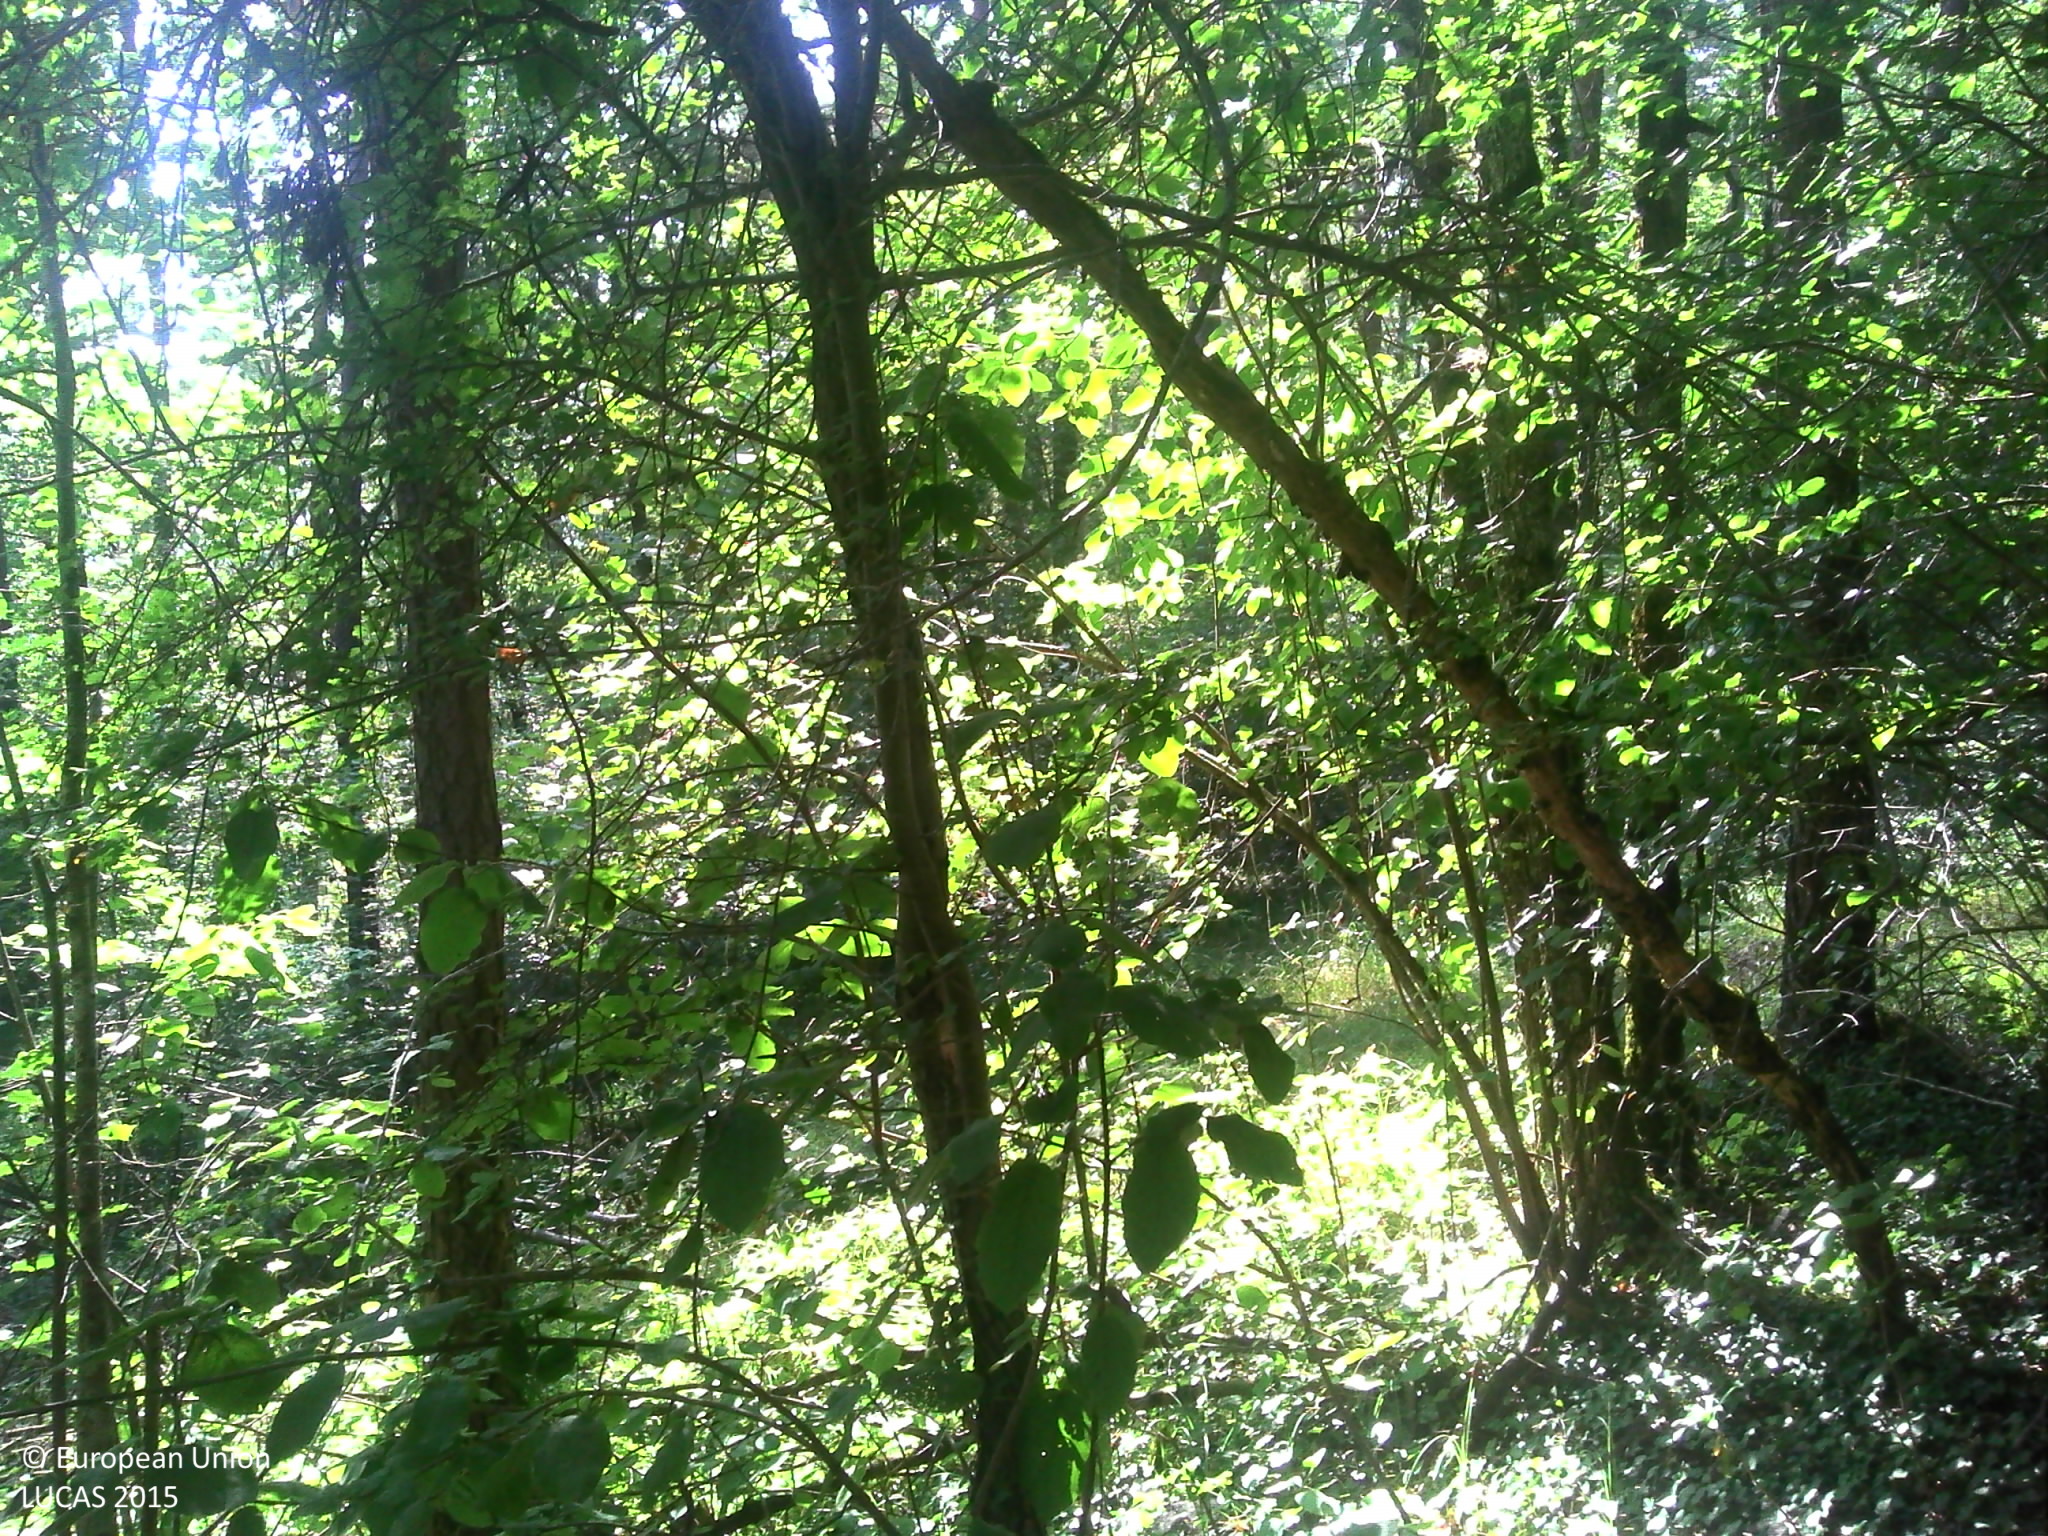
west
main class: Woodland
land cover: Pine dominated mixed woodland
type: beech forest
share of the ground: > 75 %
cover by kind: broadleaved forest trees 40 %, coniferous forest trees 35 %, herbaceous plants 15 %, lichens and mosses 10 %
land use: Forestry
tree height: > 5 m
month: July
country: FR
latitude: 48.1072
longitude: 4.9356
